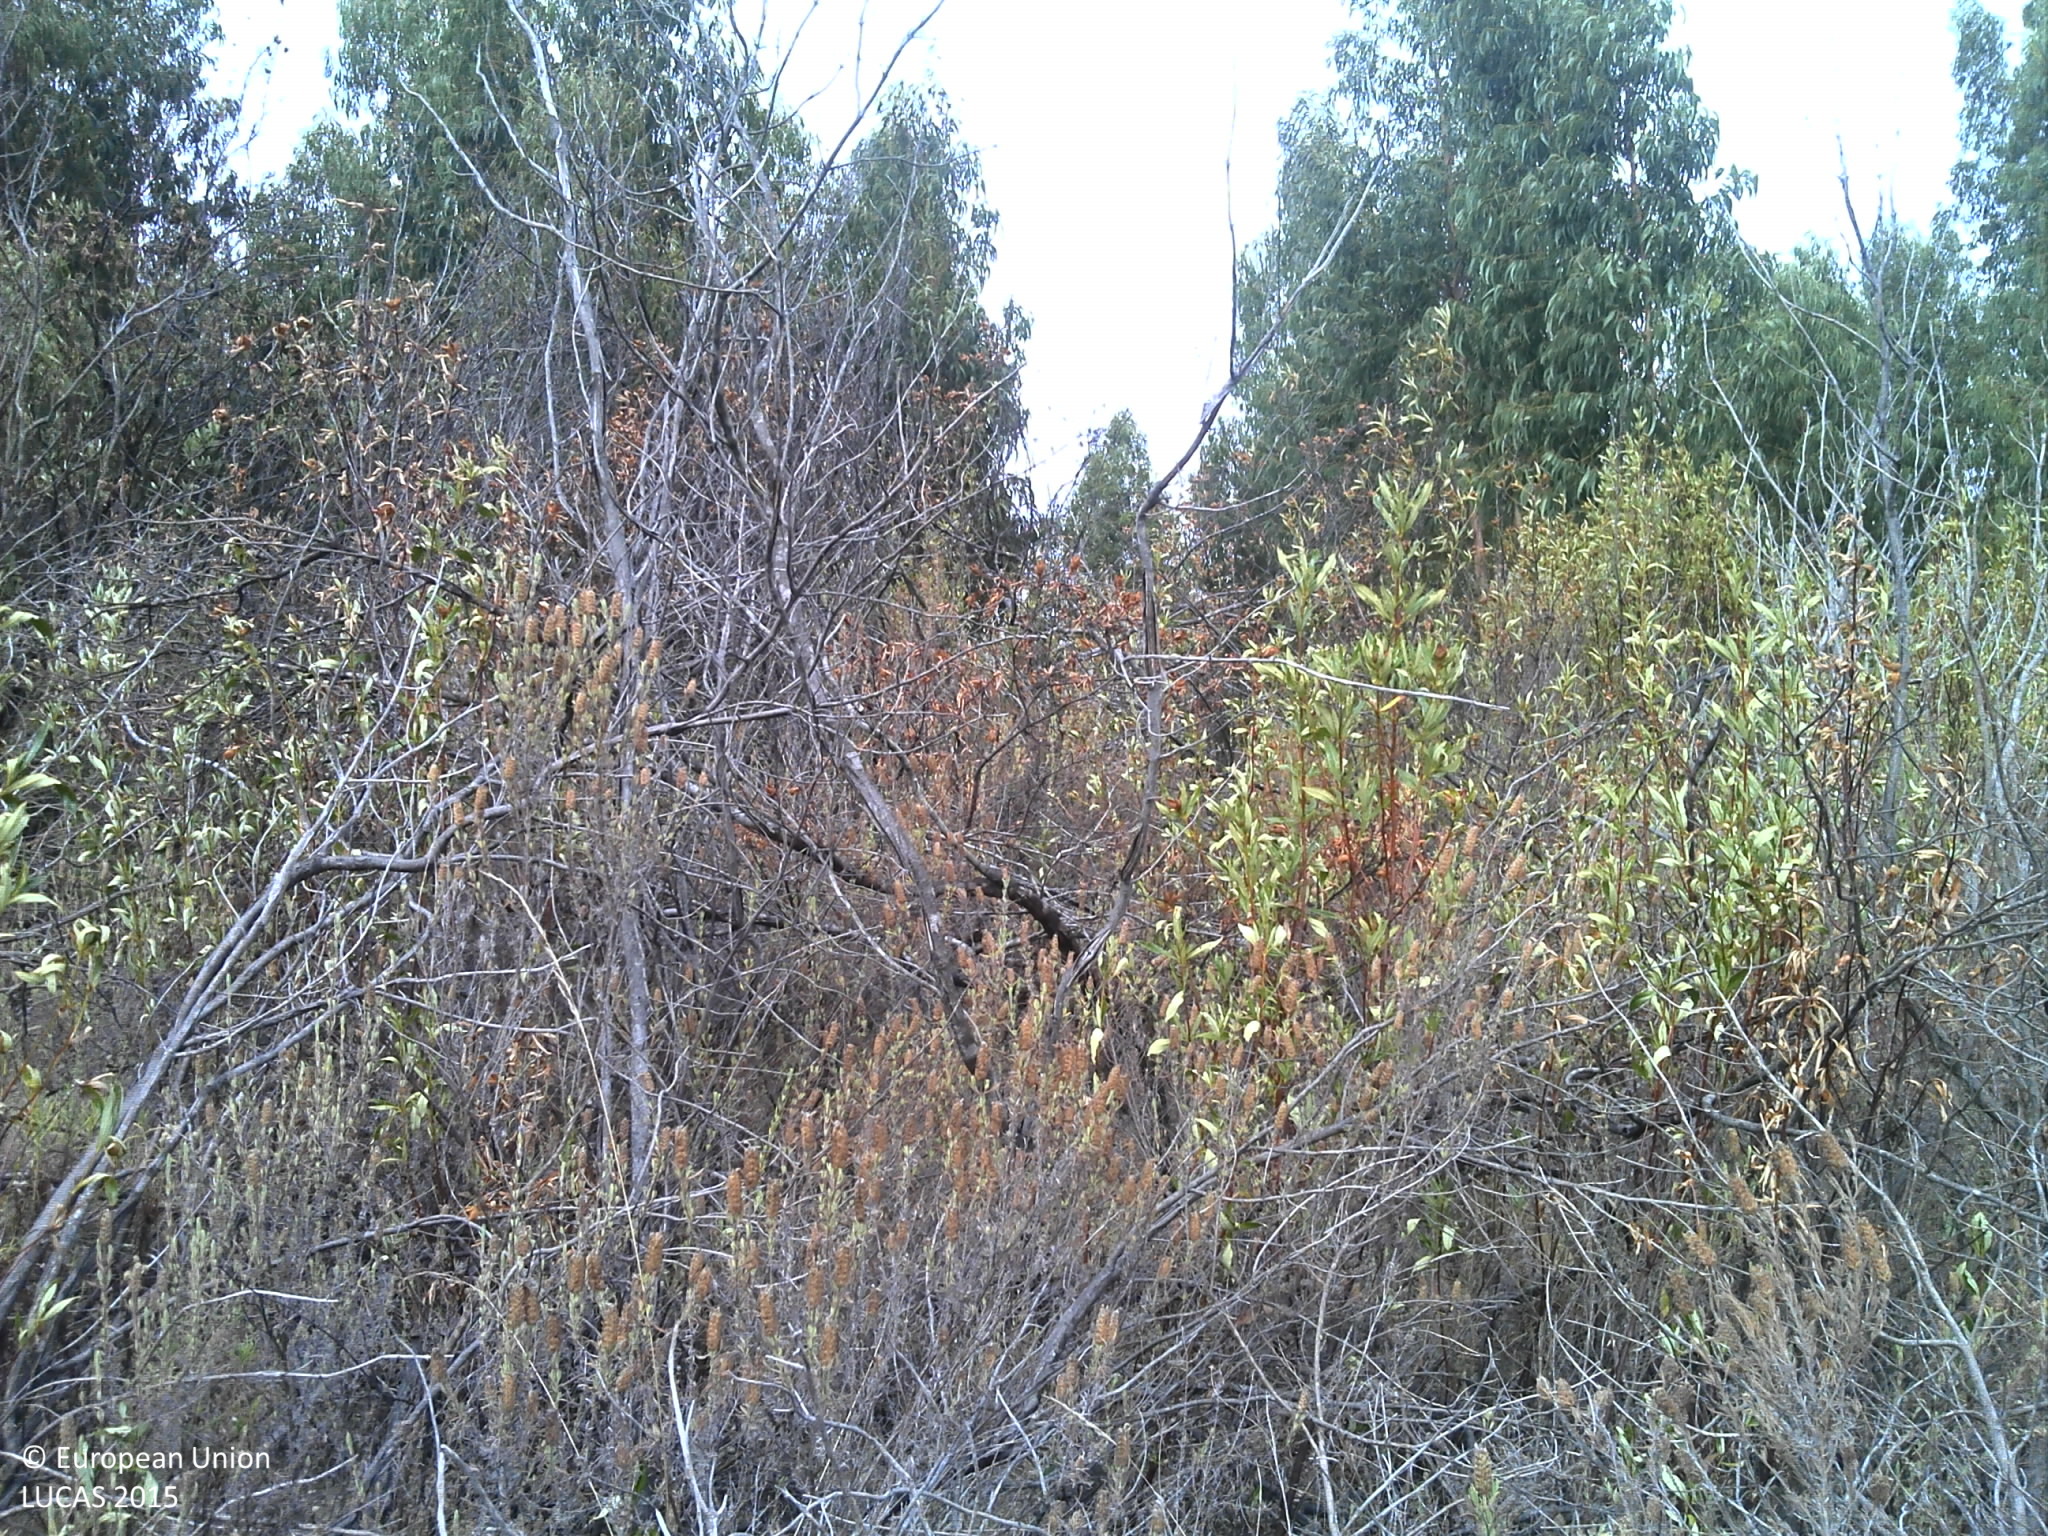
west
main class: Shrubland
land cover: Shrubland with sparse tree cover
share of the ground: > 75 %
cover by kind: shrubs 75 %, herbaceous plants 15 %, broadleaved forest trees 5 %, unconsolidated bare surface 5 %
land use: Abandoned areas
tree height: < 5 m
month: July
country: PT
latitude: 37.3499
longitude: -8.7411
